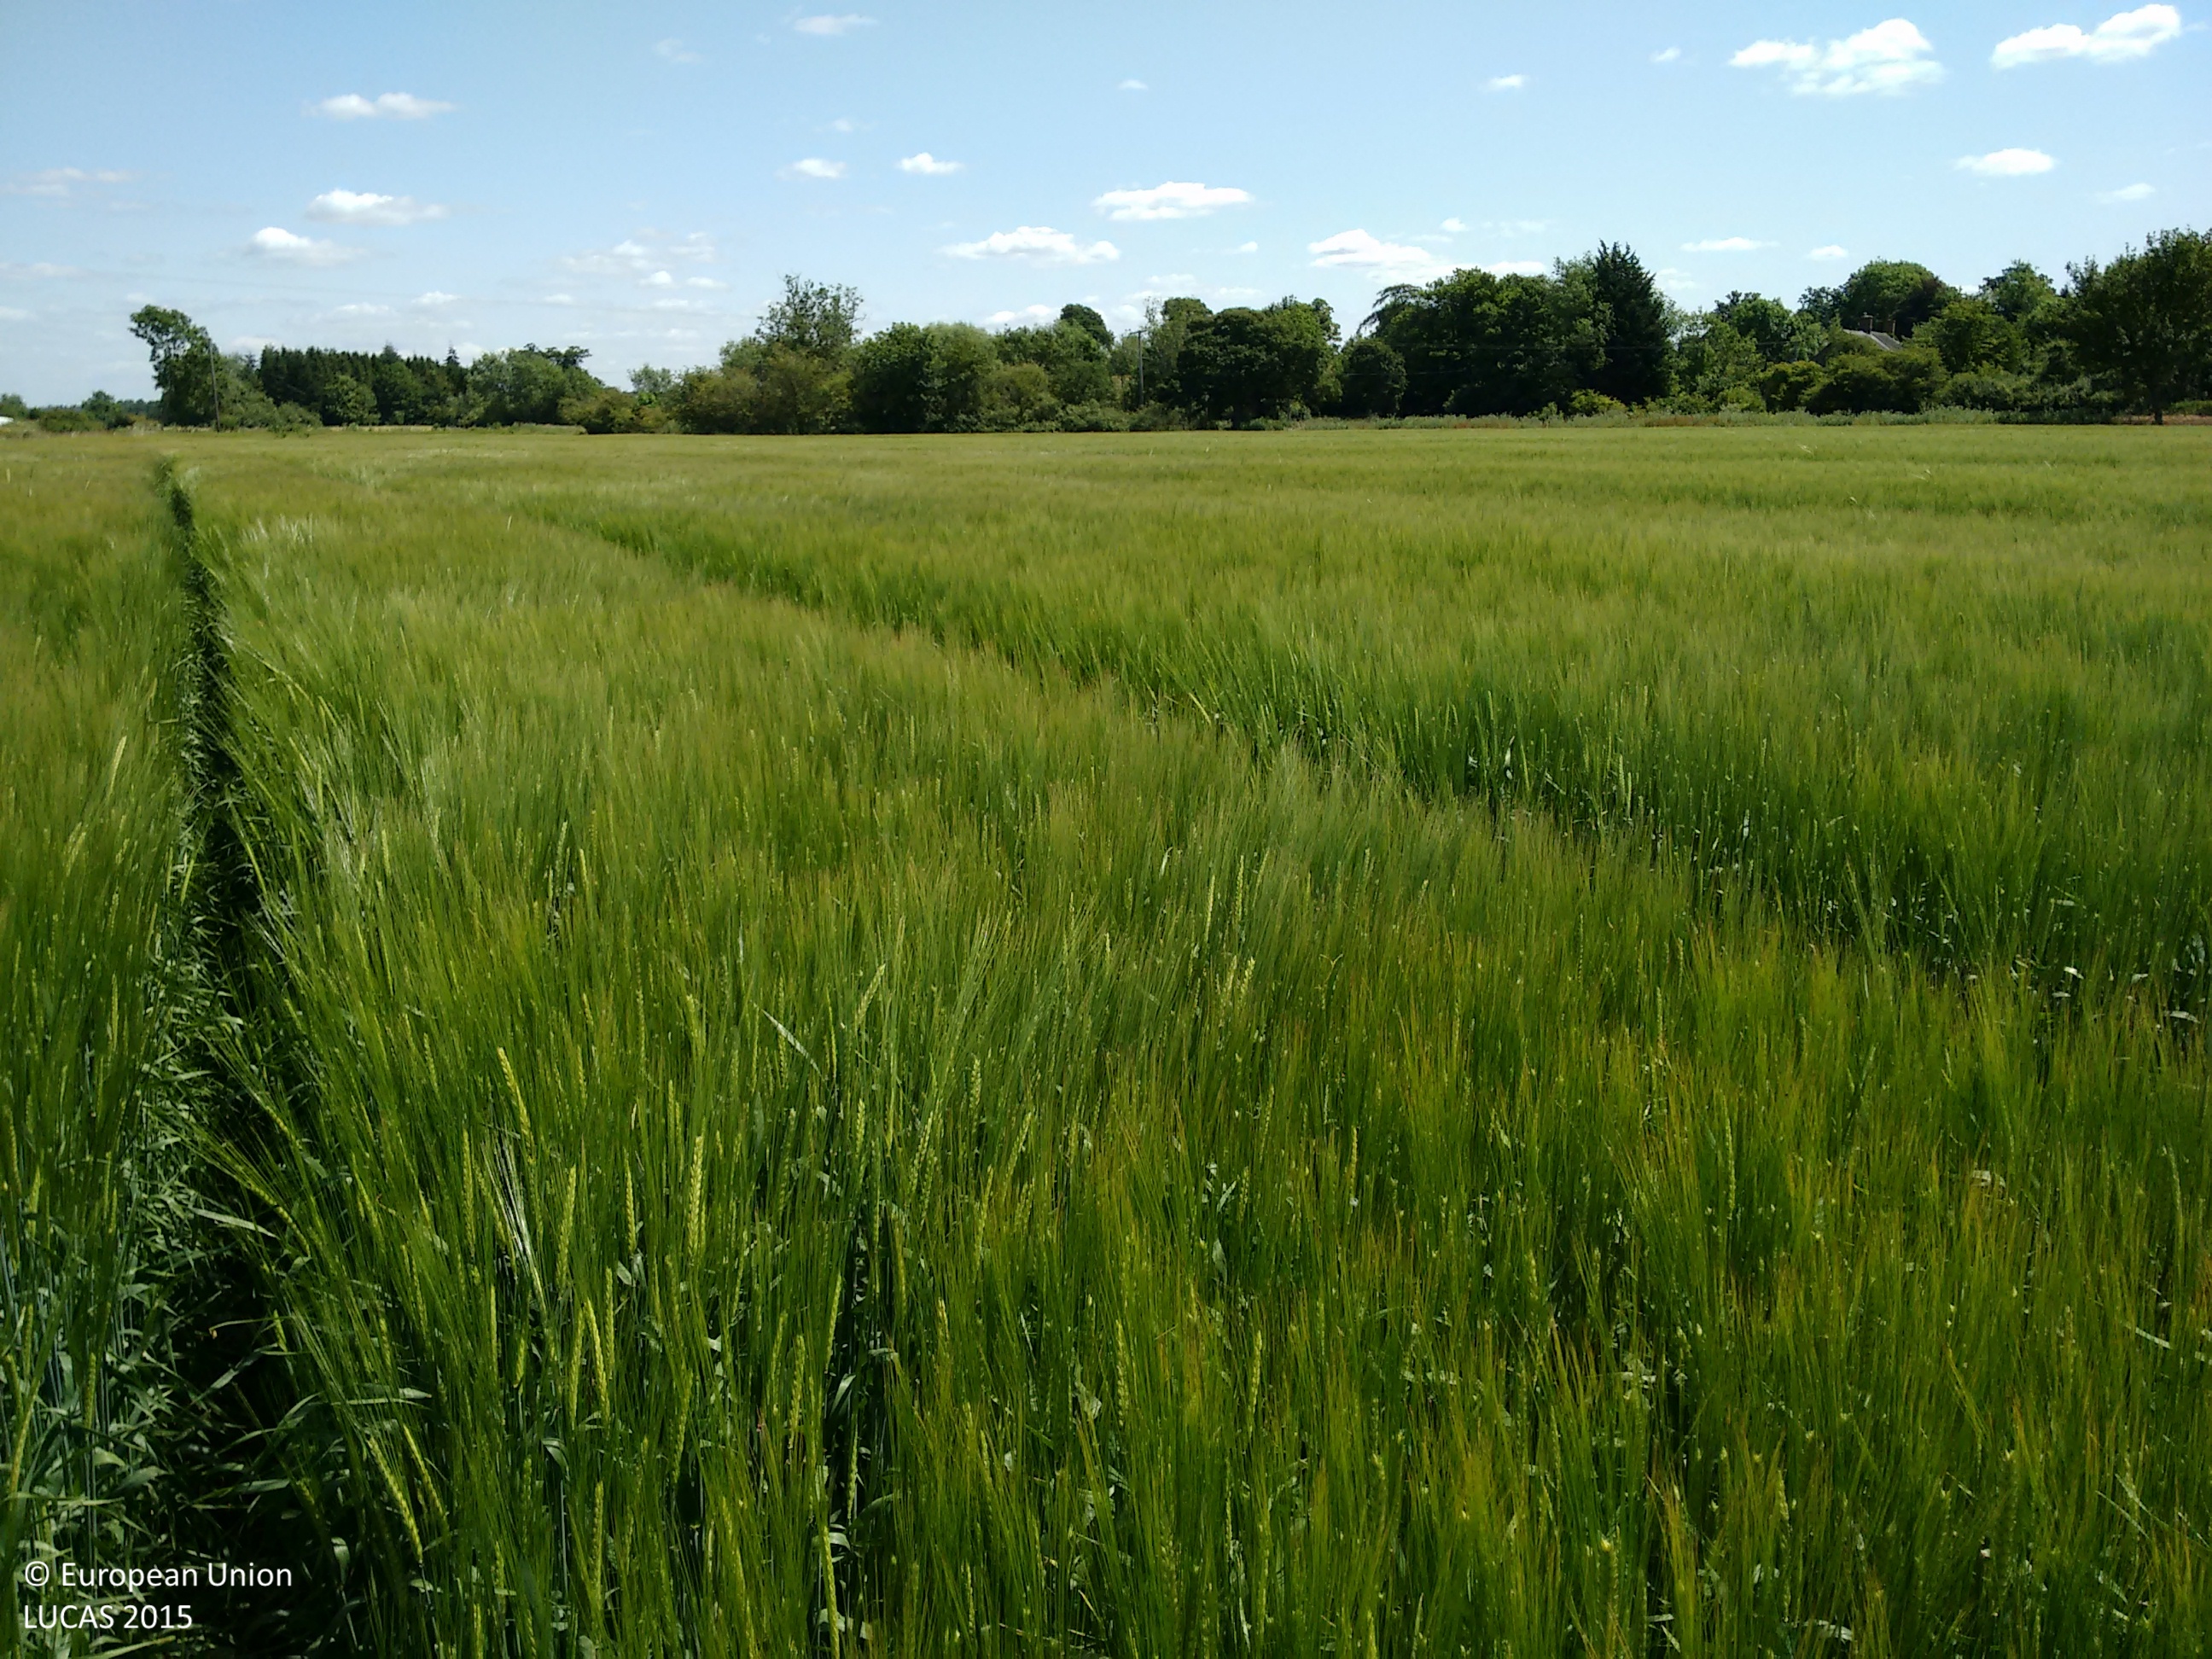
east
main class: Cropland
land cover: Barley
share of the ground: > 75 %
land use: Agriculture (excluding fallow land and kitchen gardens)
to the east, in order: Barley; Abandoned hedges; Electric lines; Other bare soil; Electric lines; Grass margins; Tracks; Ditches and canals; Abandoned hedges; Grass margins; Common wheat; Grass margins; Broadleaved woodland
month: July
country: GB
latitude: 51.9987
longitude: -1.3075
